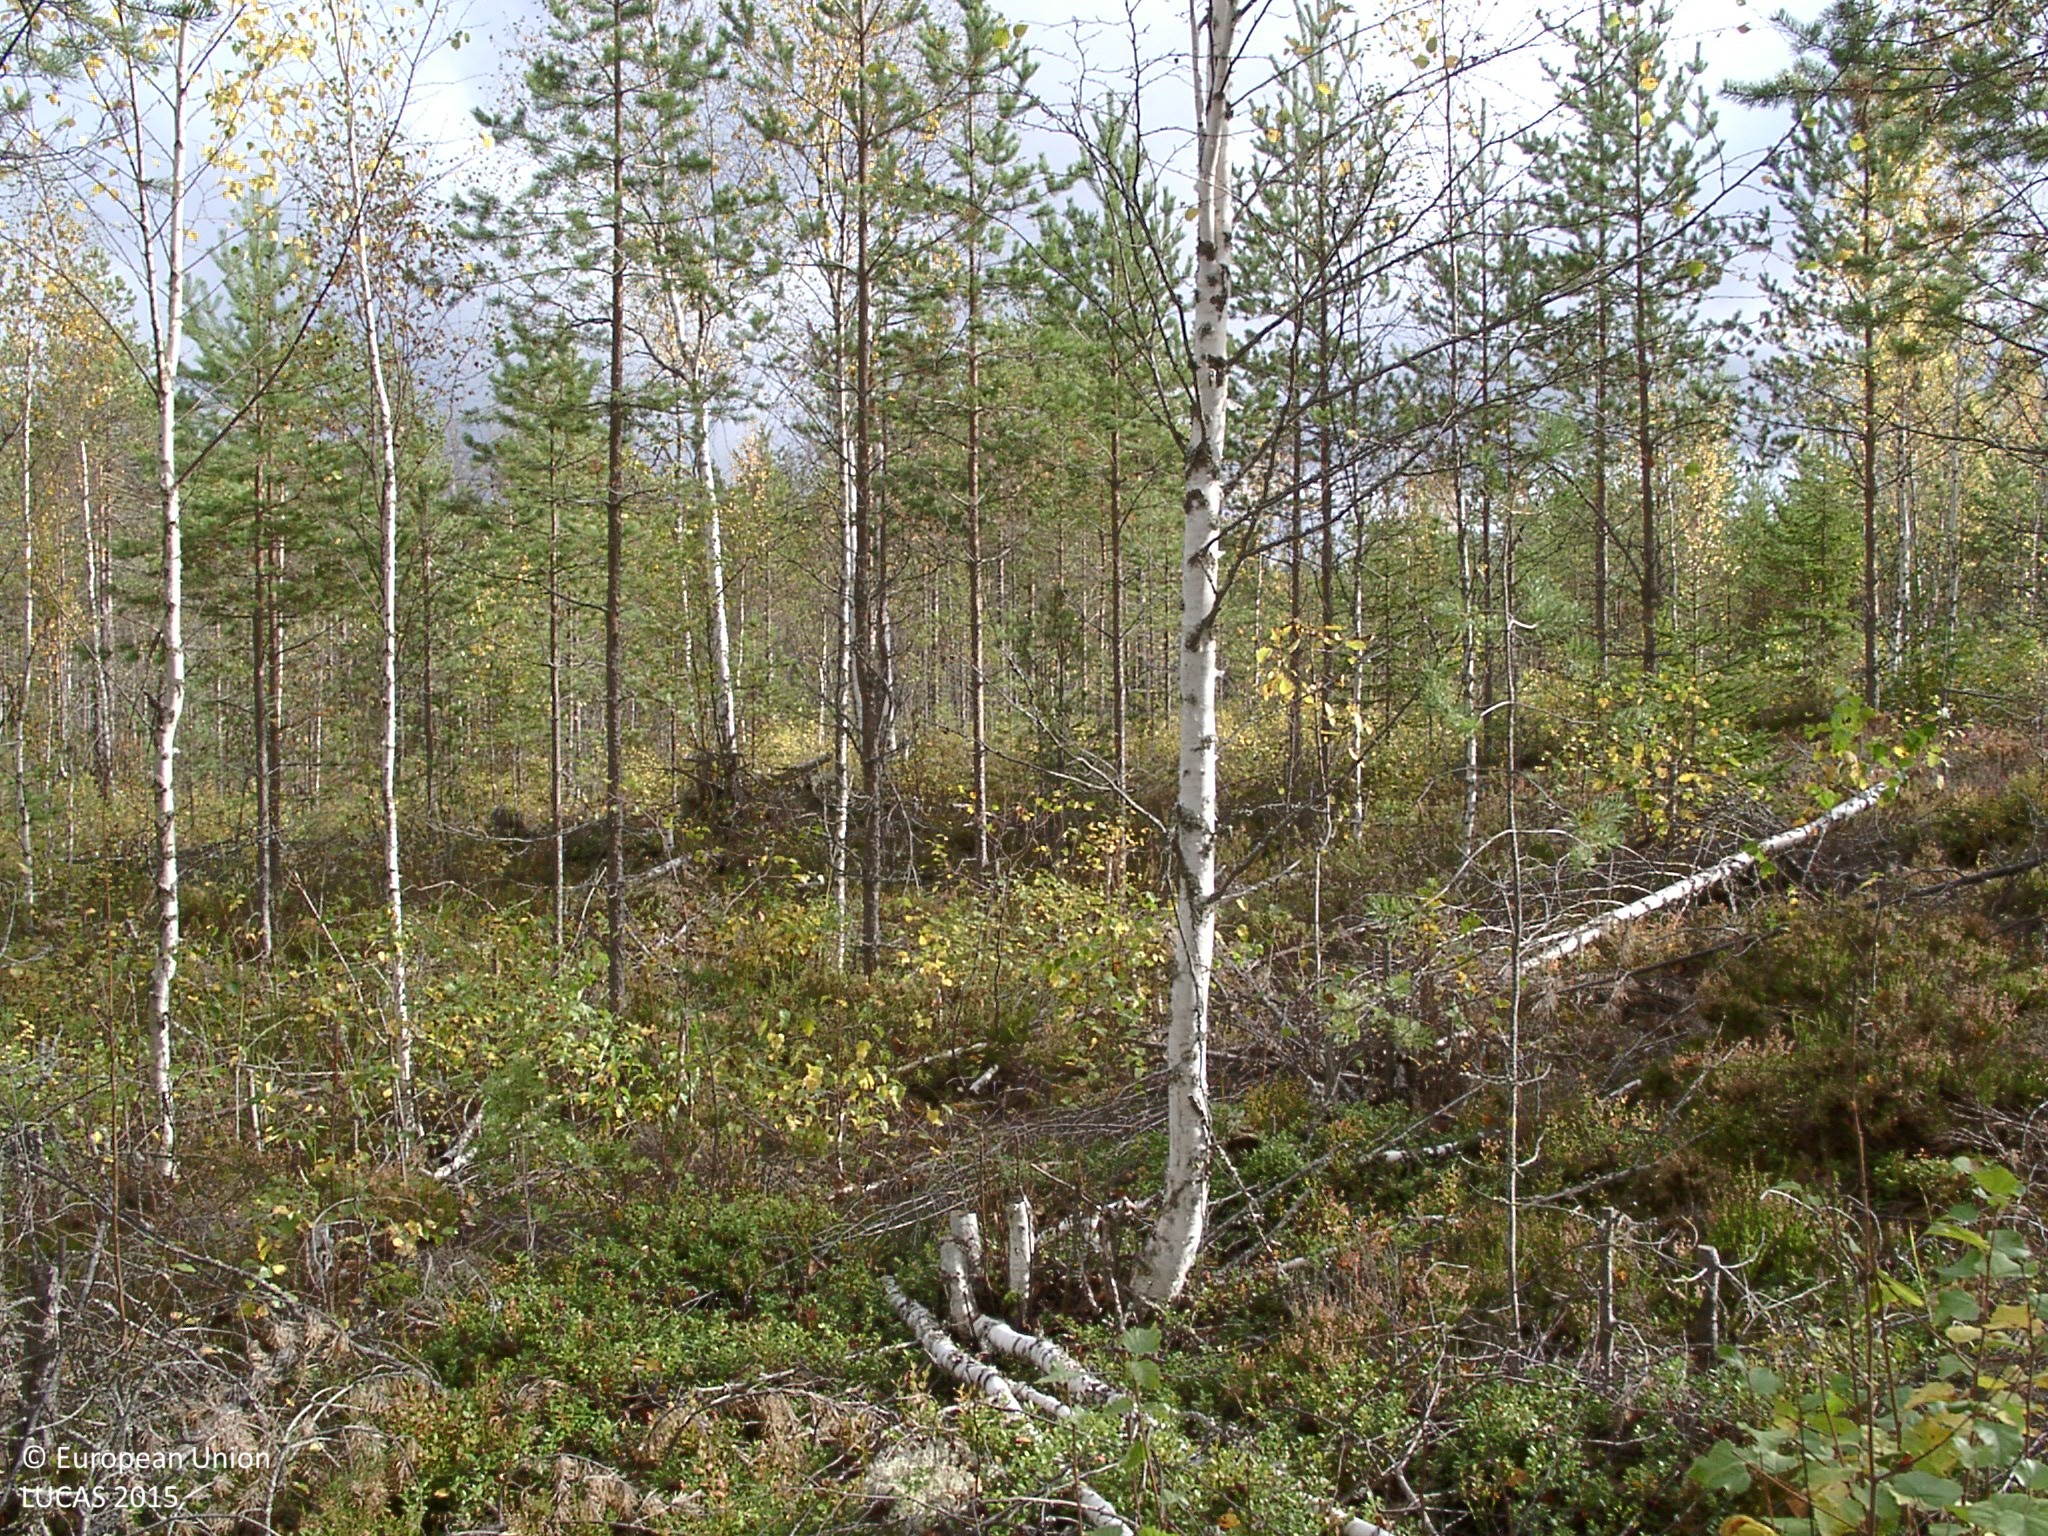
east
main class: Woodland
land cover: Pine dominated mixed woodland
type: boreal forest
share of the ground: 10 - 25 %
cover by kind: shrubs 40 %, lichens and mosses 30 %, coniferous forest trees 10 %, broadleaved forest trees 10 %
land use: Forestry
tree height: > 5 m
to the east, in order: Pine dominated mixed woodland; Inland marshes; Pine dominated coniferous woodland; Ditches and canals; Pine dominated coniferous woodland; Peatbogs; Pine dominated mixed woodland; Other mixed woodland; Other coniferous woodland; Tracks; Other coniferous woodland; Pine dominated coniferous woodland
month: September
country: FI
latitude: 62.5804
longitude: 25.4681
